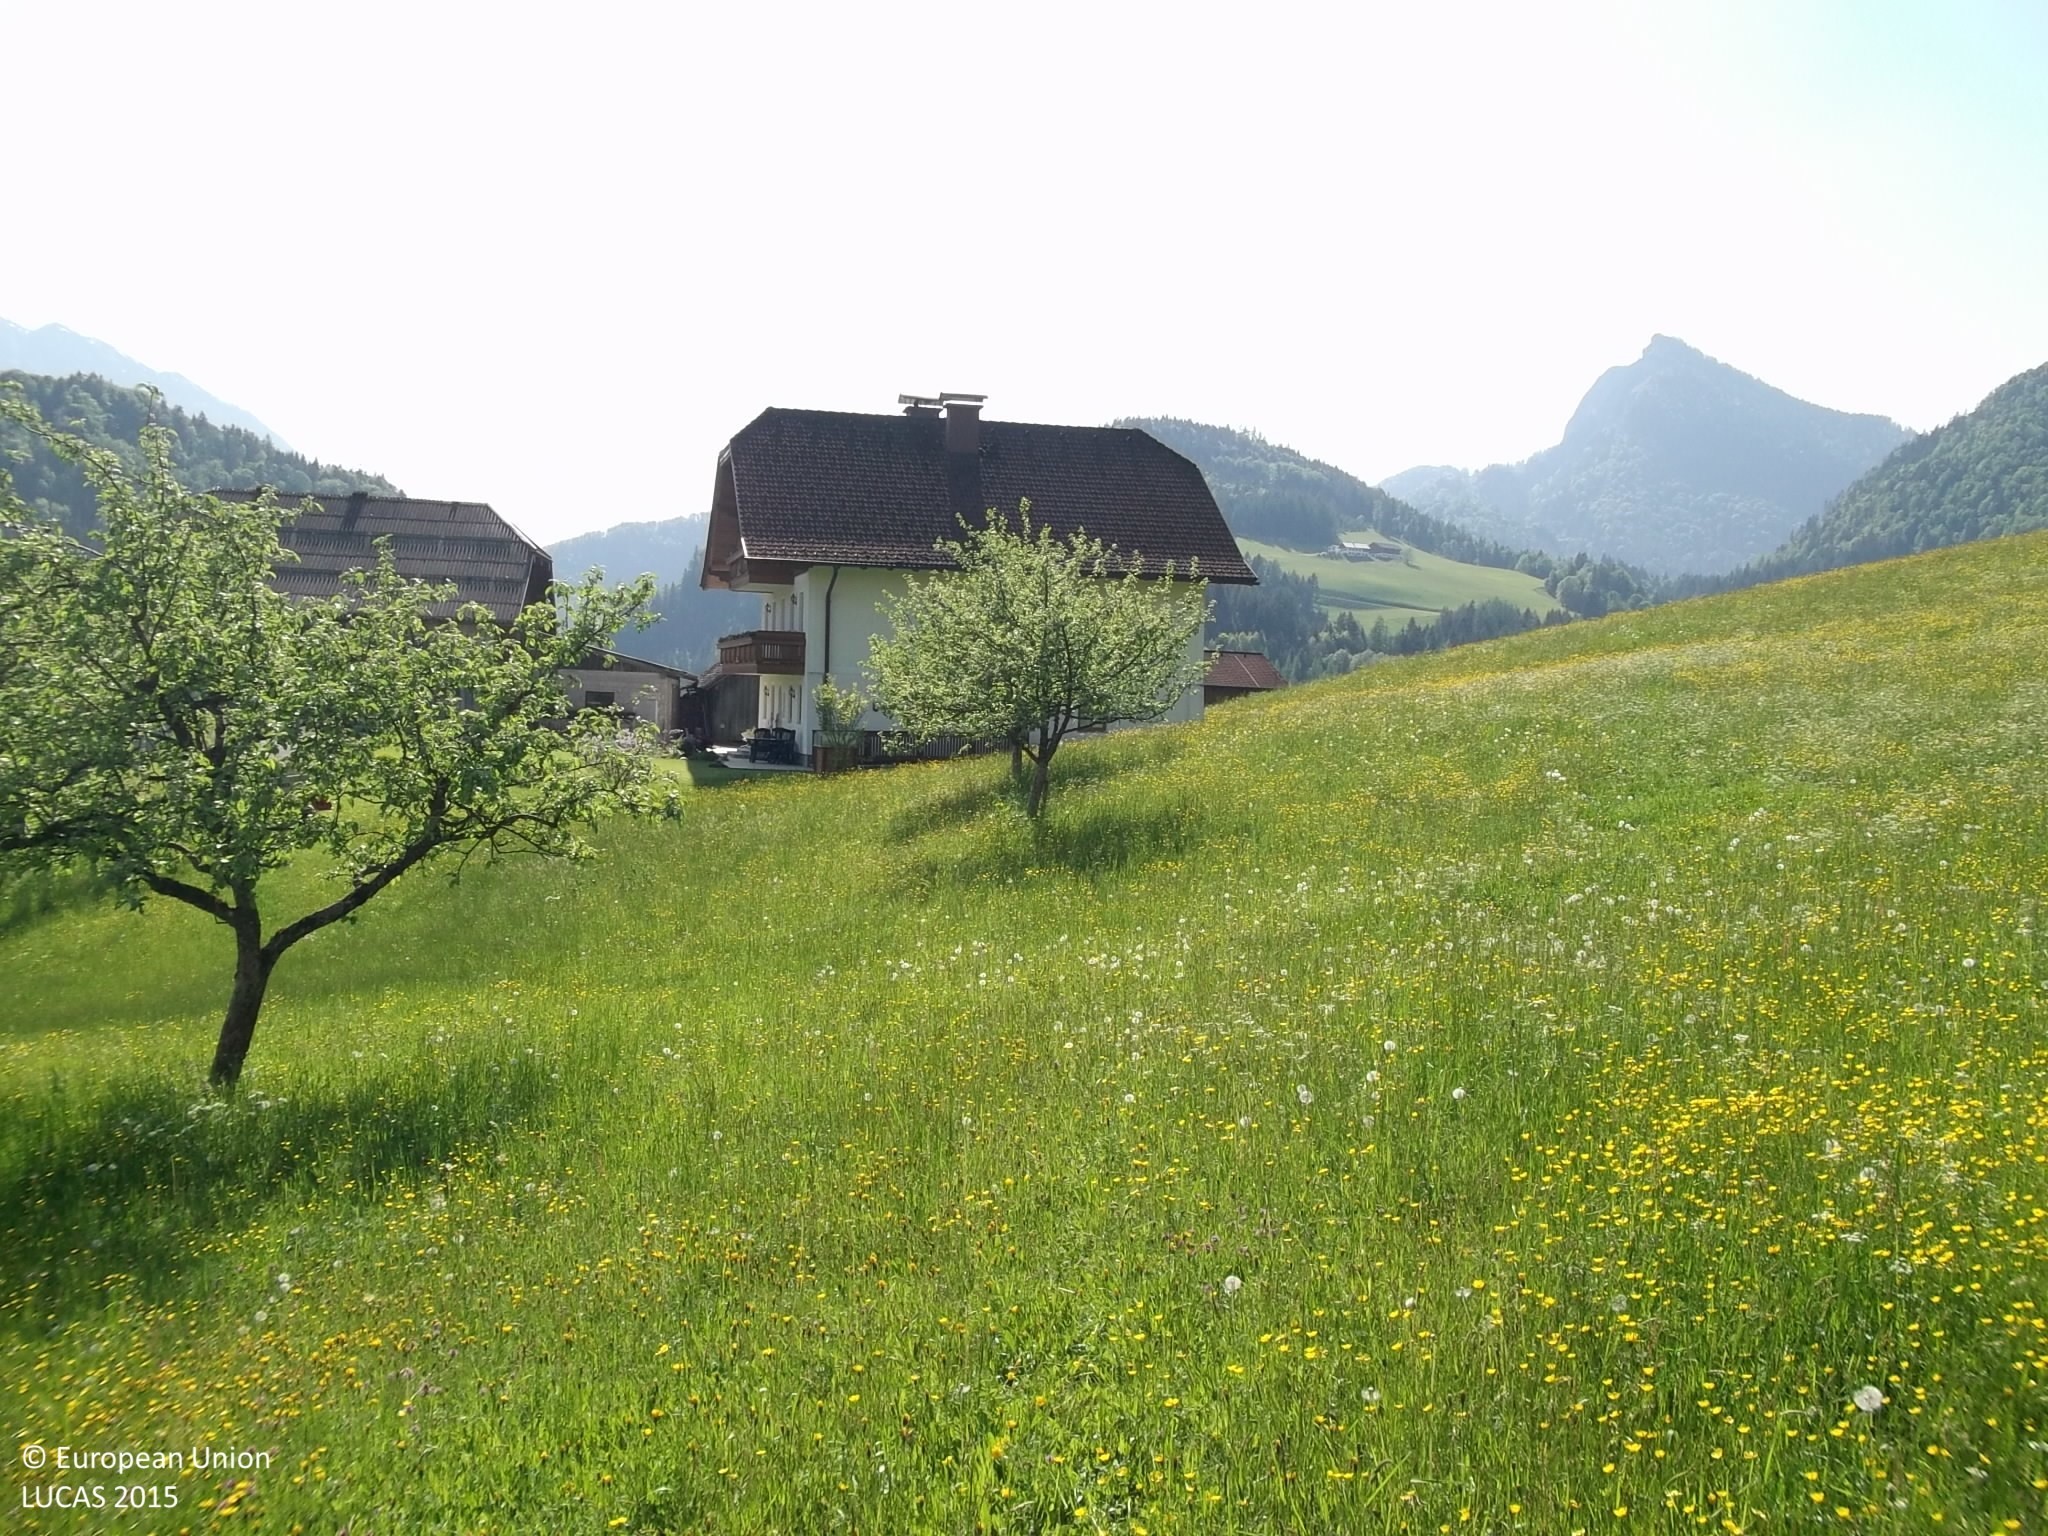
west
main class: Grassland
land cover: Grassland without tree/shrub cover
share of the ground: > 75 %
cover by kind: herbaceous plants 100 %
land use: Agriculture (excluding fallow land and kitchen gardens)
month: May
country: AT
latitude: 47.5975
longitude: 13.3101
